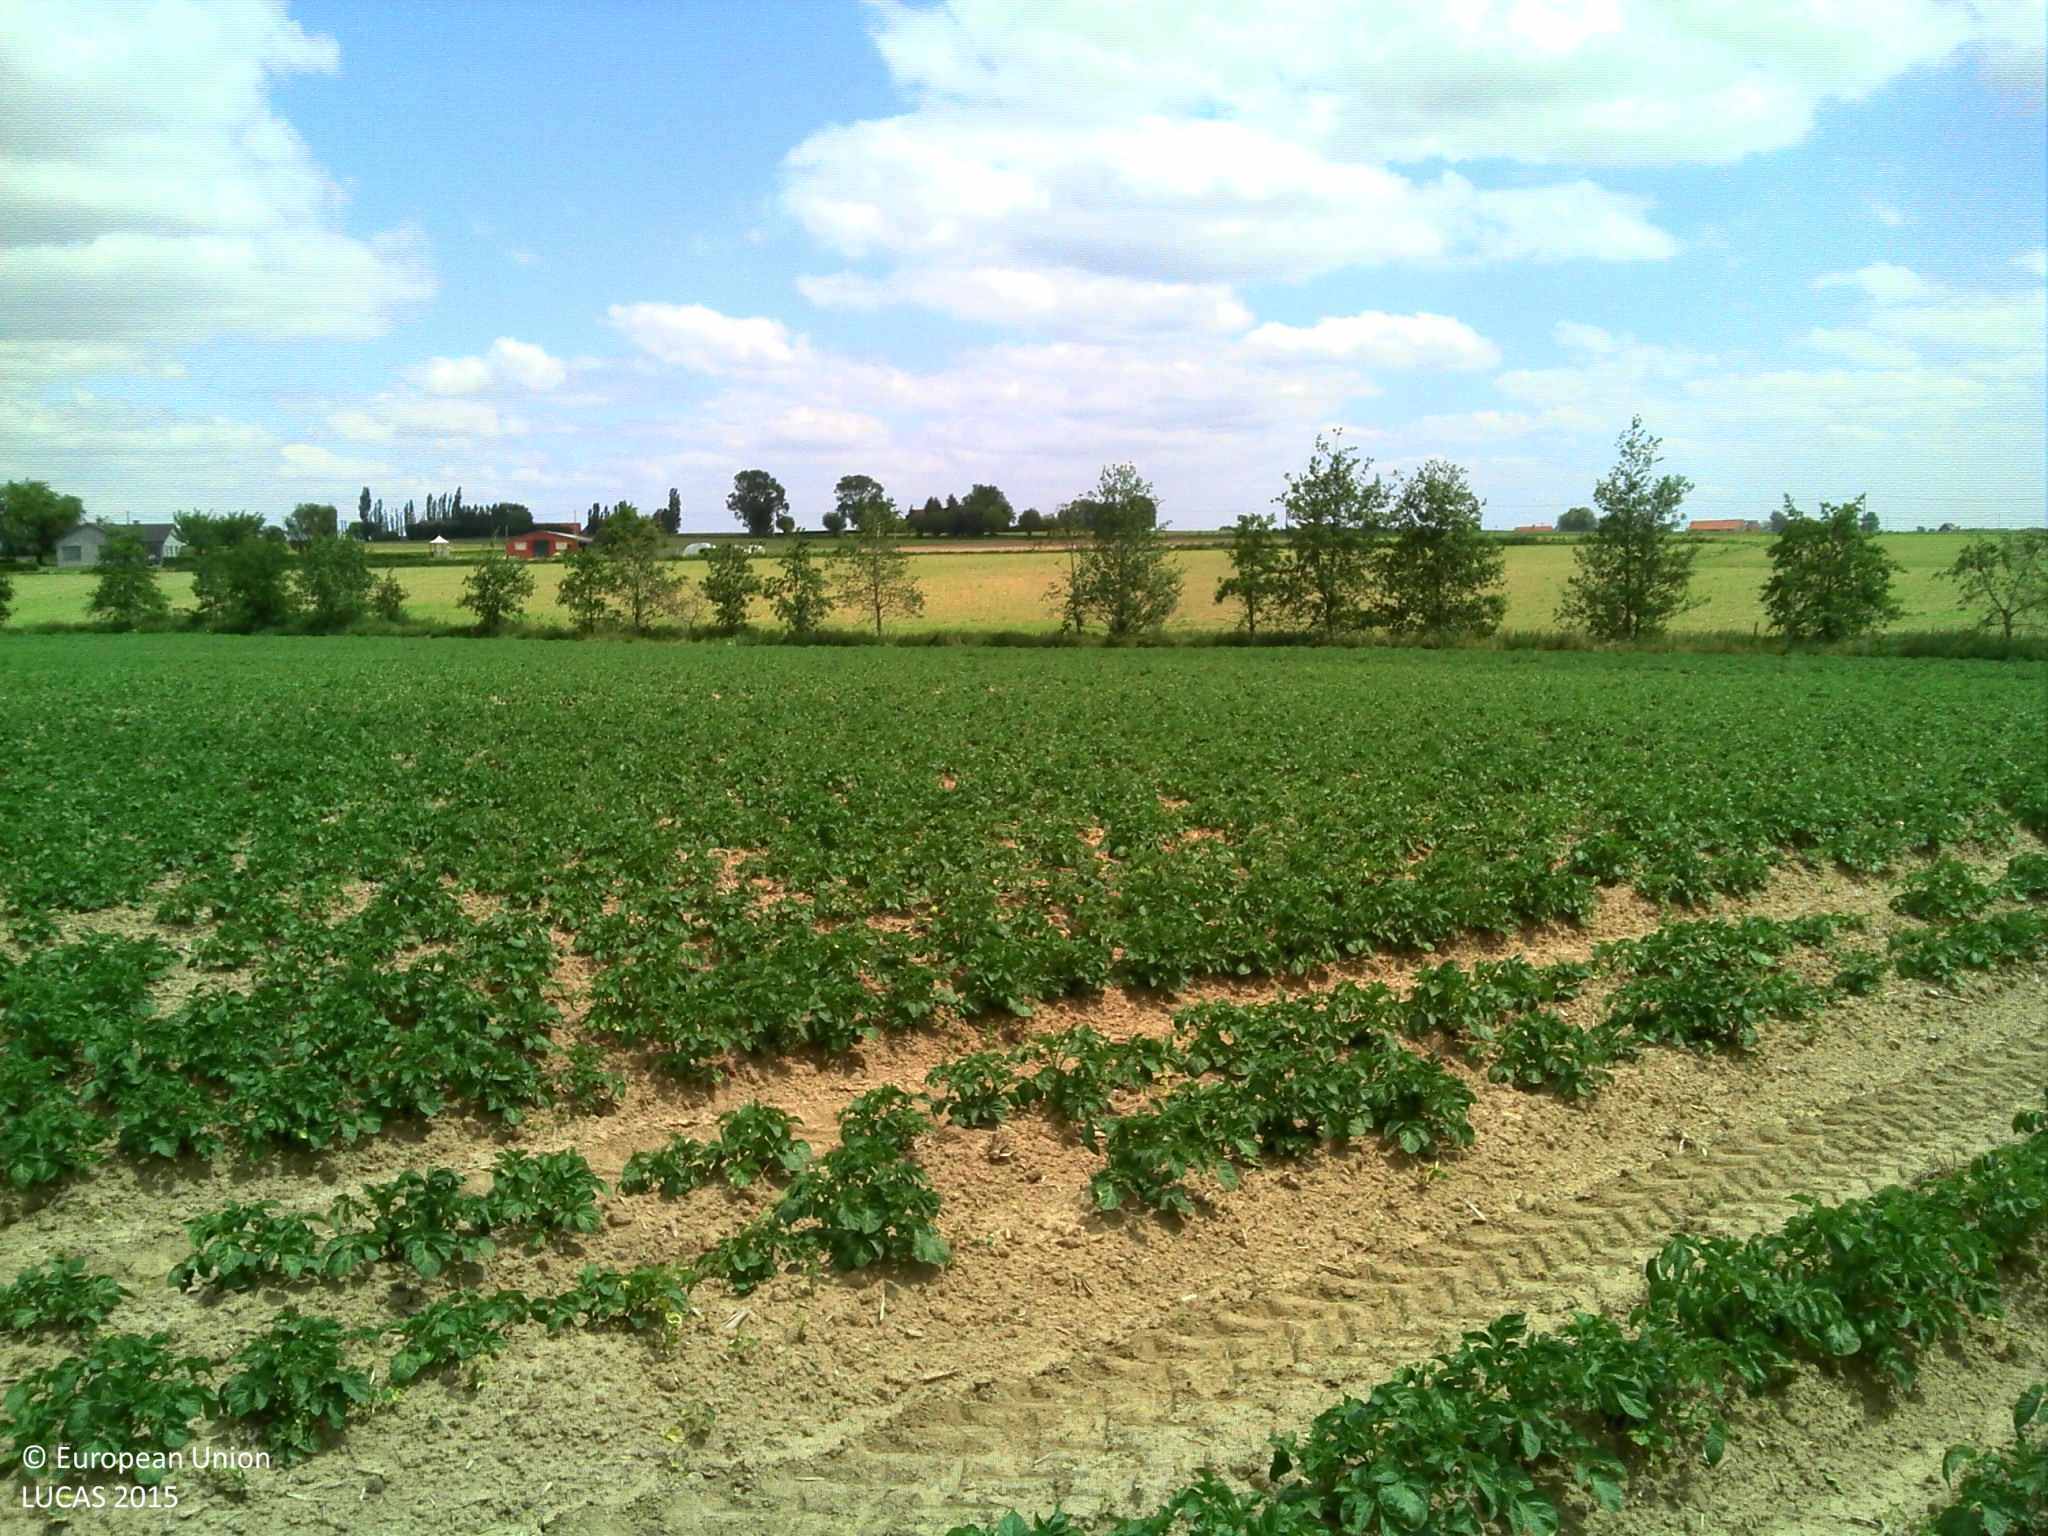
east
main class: Cropland
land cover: Potatoes
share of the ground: 10 - 25 %
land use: Agriculture (excluding fallow land and kitchen gardens)
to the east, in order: Potatoes; Grass margins; Ditches and canals; Grass margins; Lines of trees; Maize
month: June
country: BE
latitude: 50.8386
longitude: 2.7607
